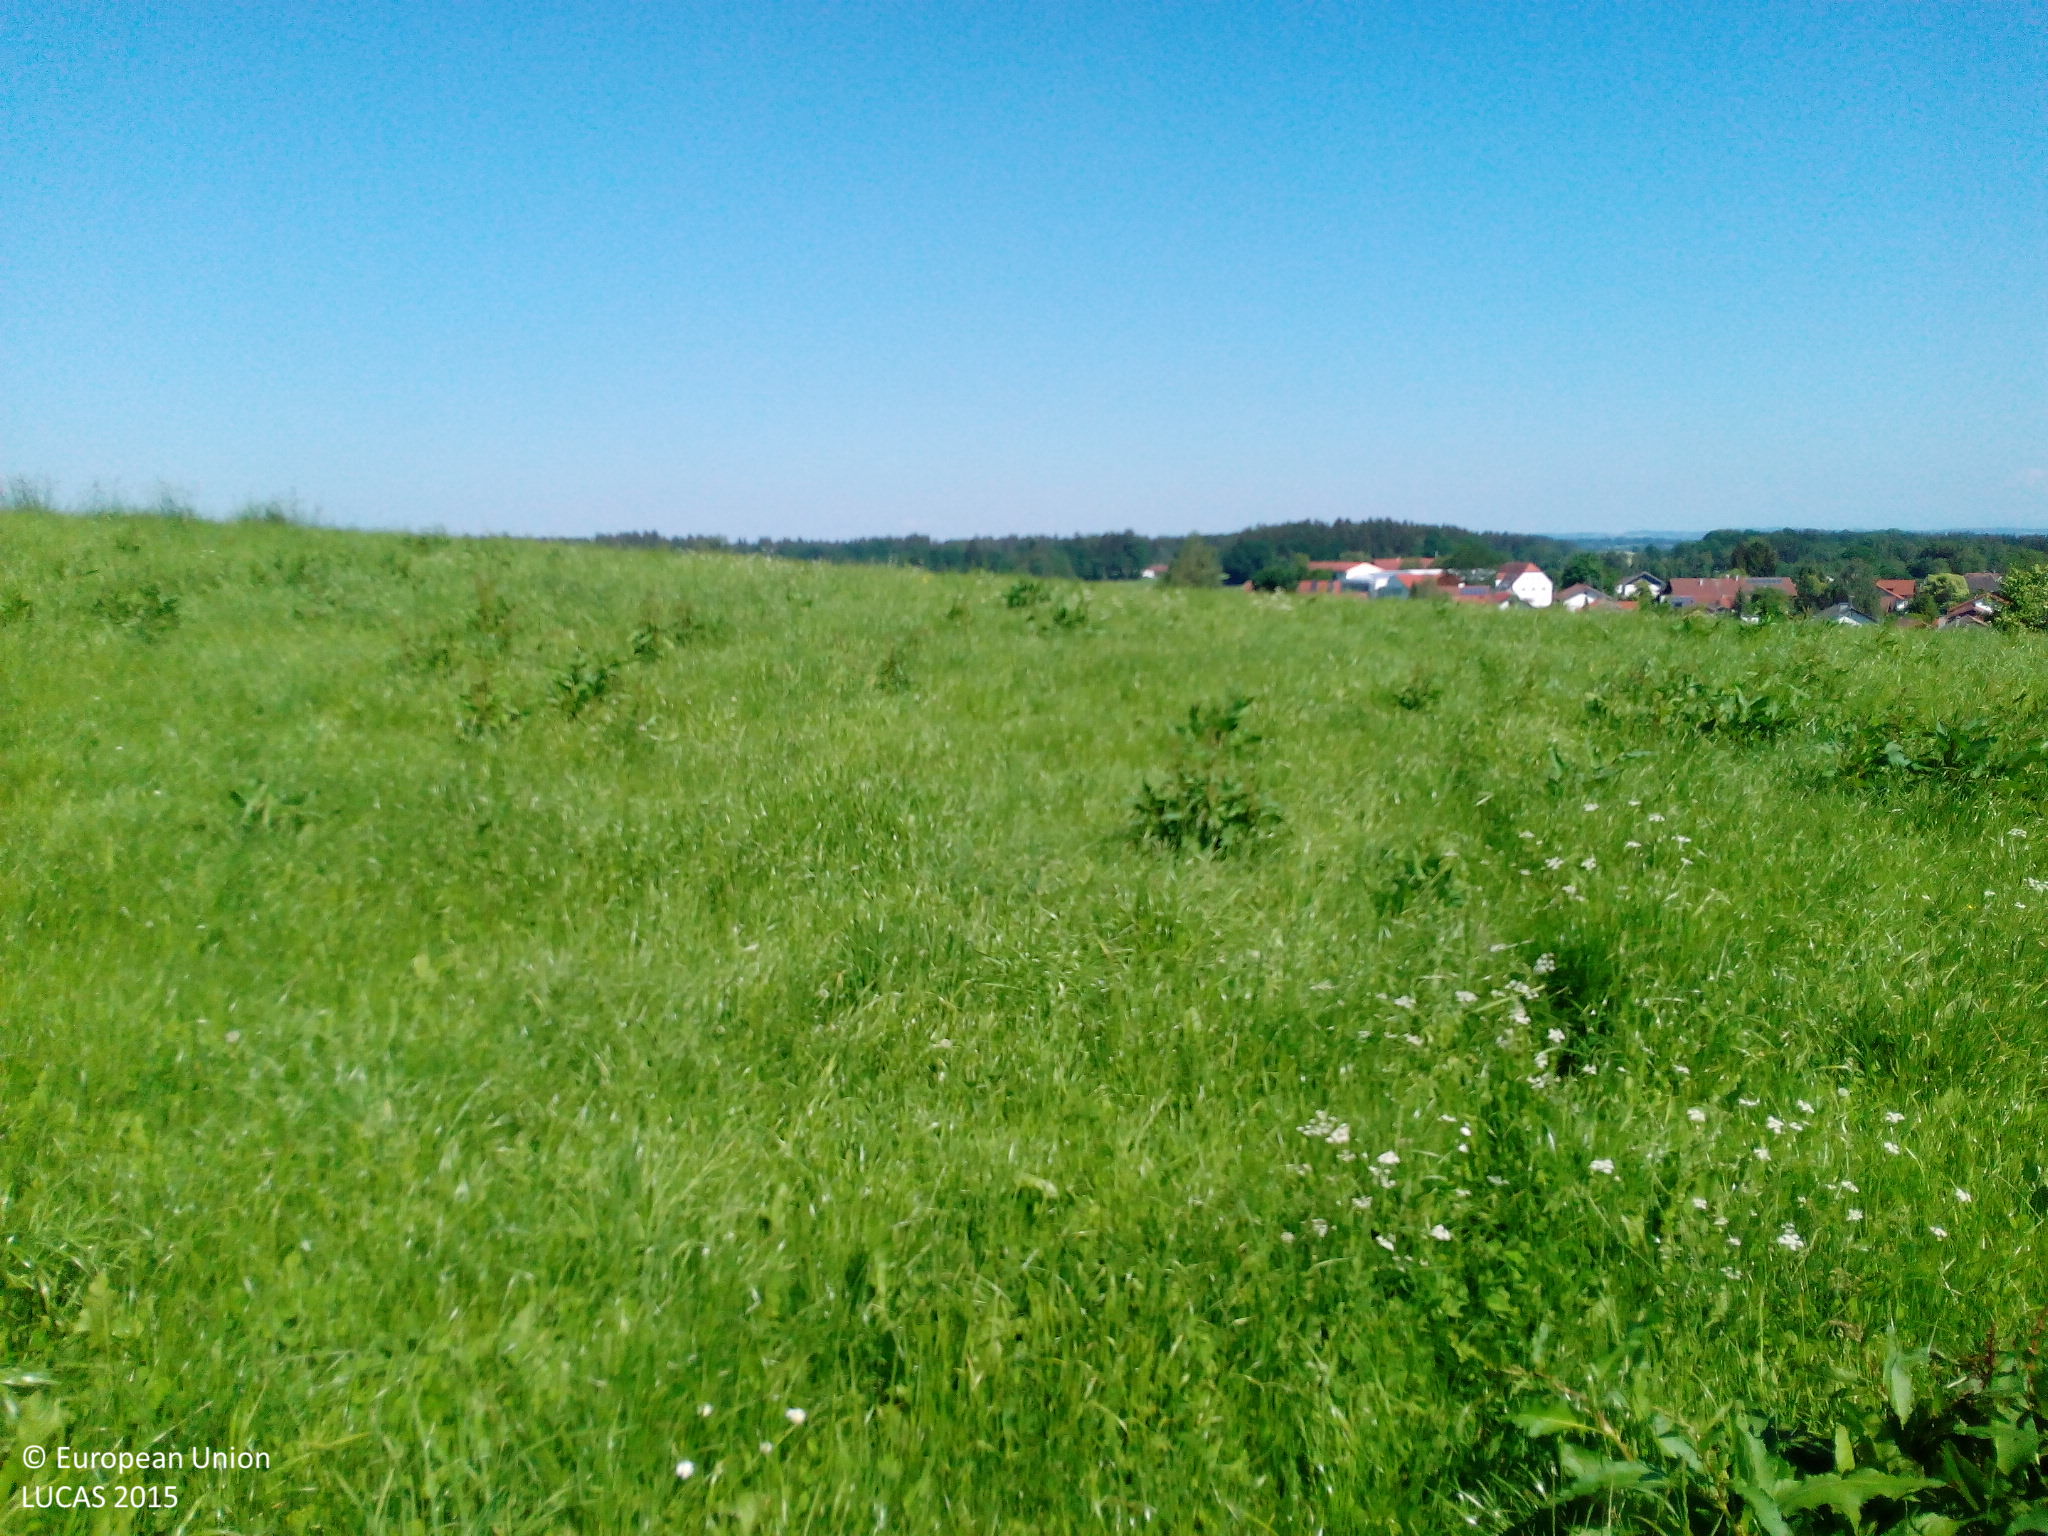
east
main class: Grassland
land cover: Grassland without tree/shrub cover
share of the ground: > 75 %
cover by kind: herbaceous plants 100 %
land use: Agriculture (excluding fallow land and kitchen gardens)
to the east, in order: Grassland without tree/shrub cover; Tracks; Grassland without tree/shrub cover
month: June
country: DE
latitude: 48.0594
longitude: 12.1055
